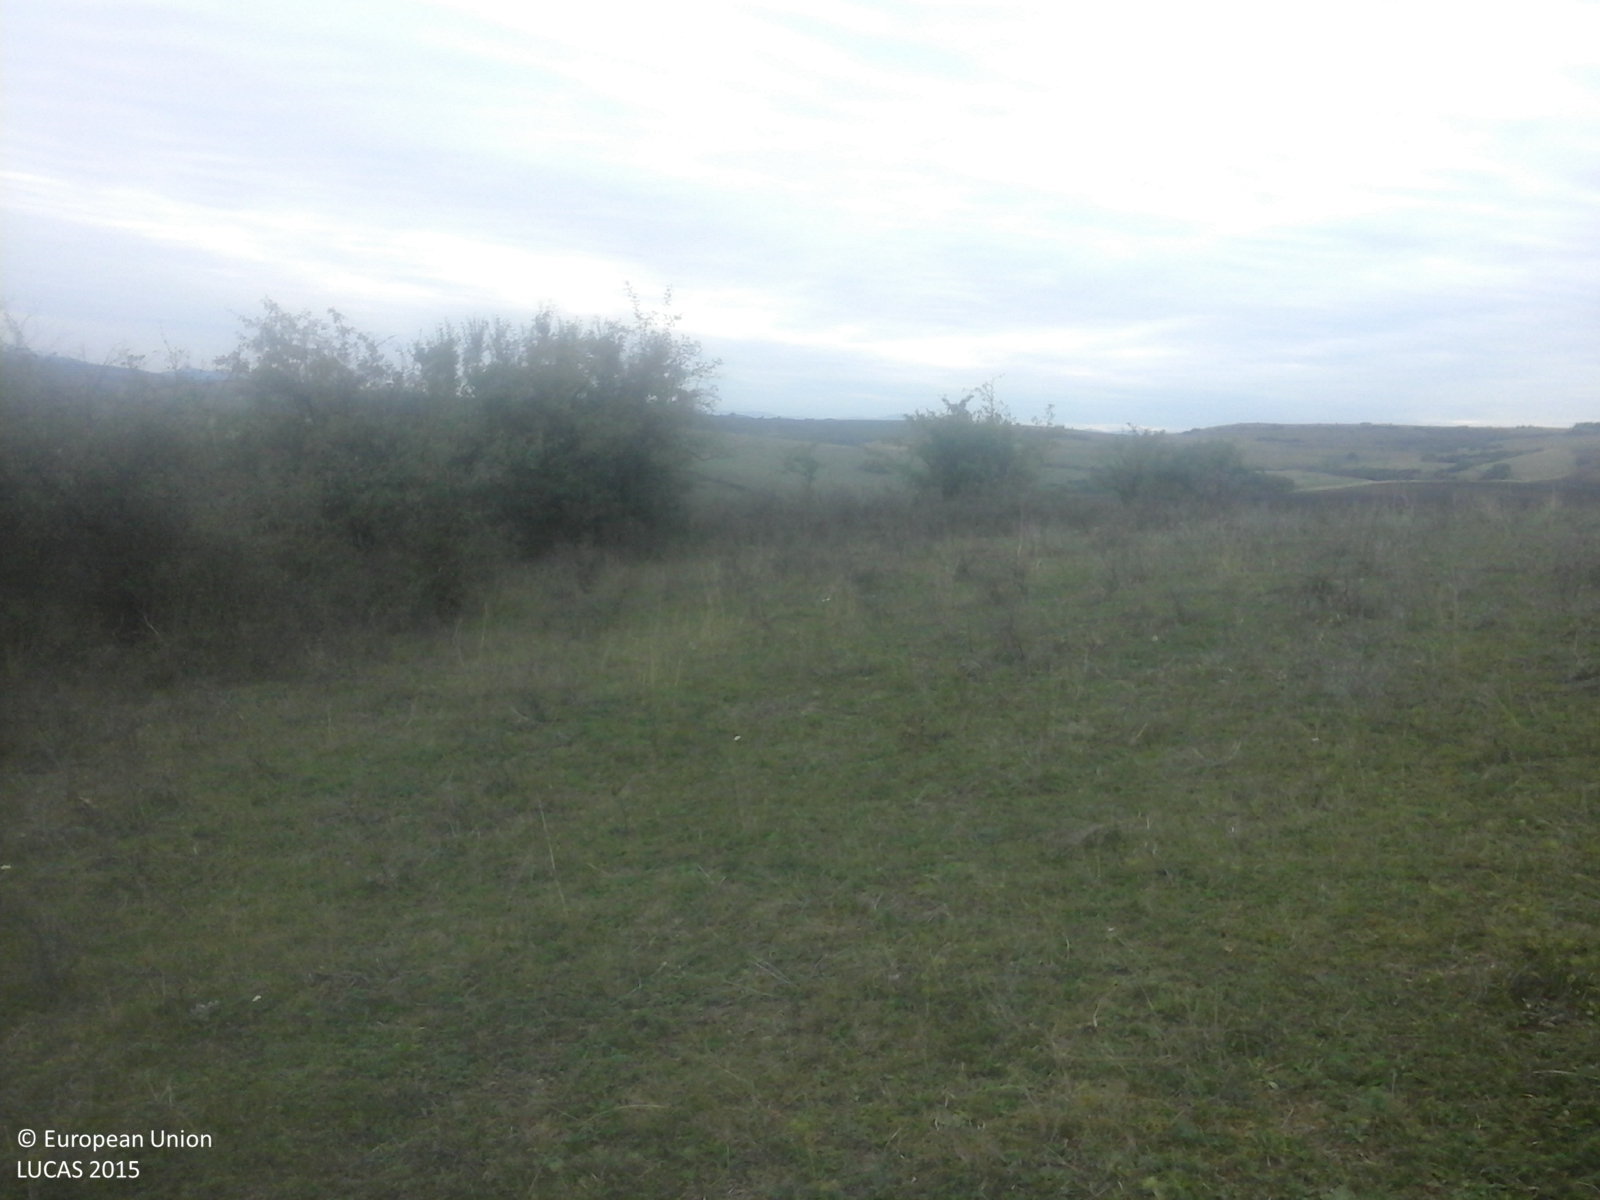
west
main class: Grassland
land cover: Grassland with sparse tree/shrub cover
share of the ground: > 75 %
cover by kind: herbaceous plants 85 %, shrubs 10 %, broadleaved forest trees 5 %
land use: Fallow land
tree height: < 5 m
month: September
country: RO
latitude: 45.9083
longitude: 23.7982
